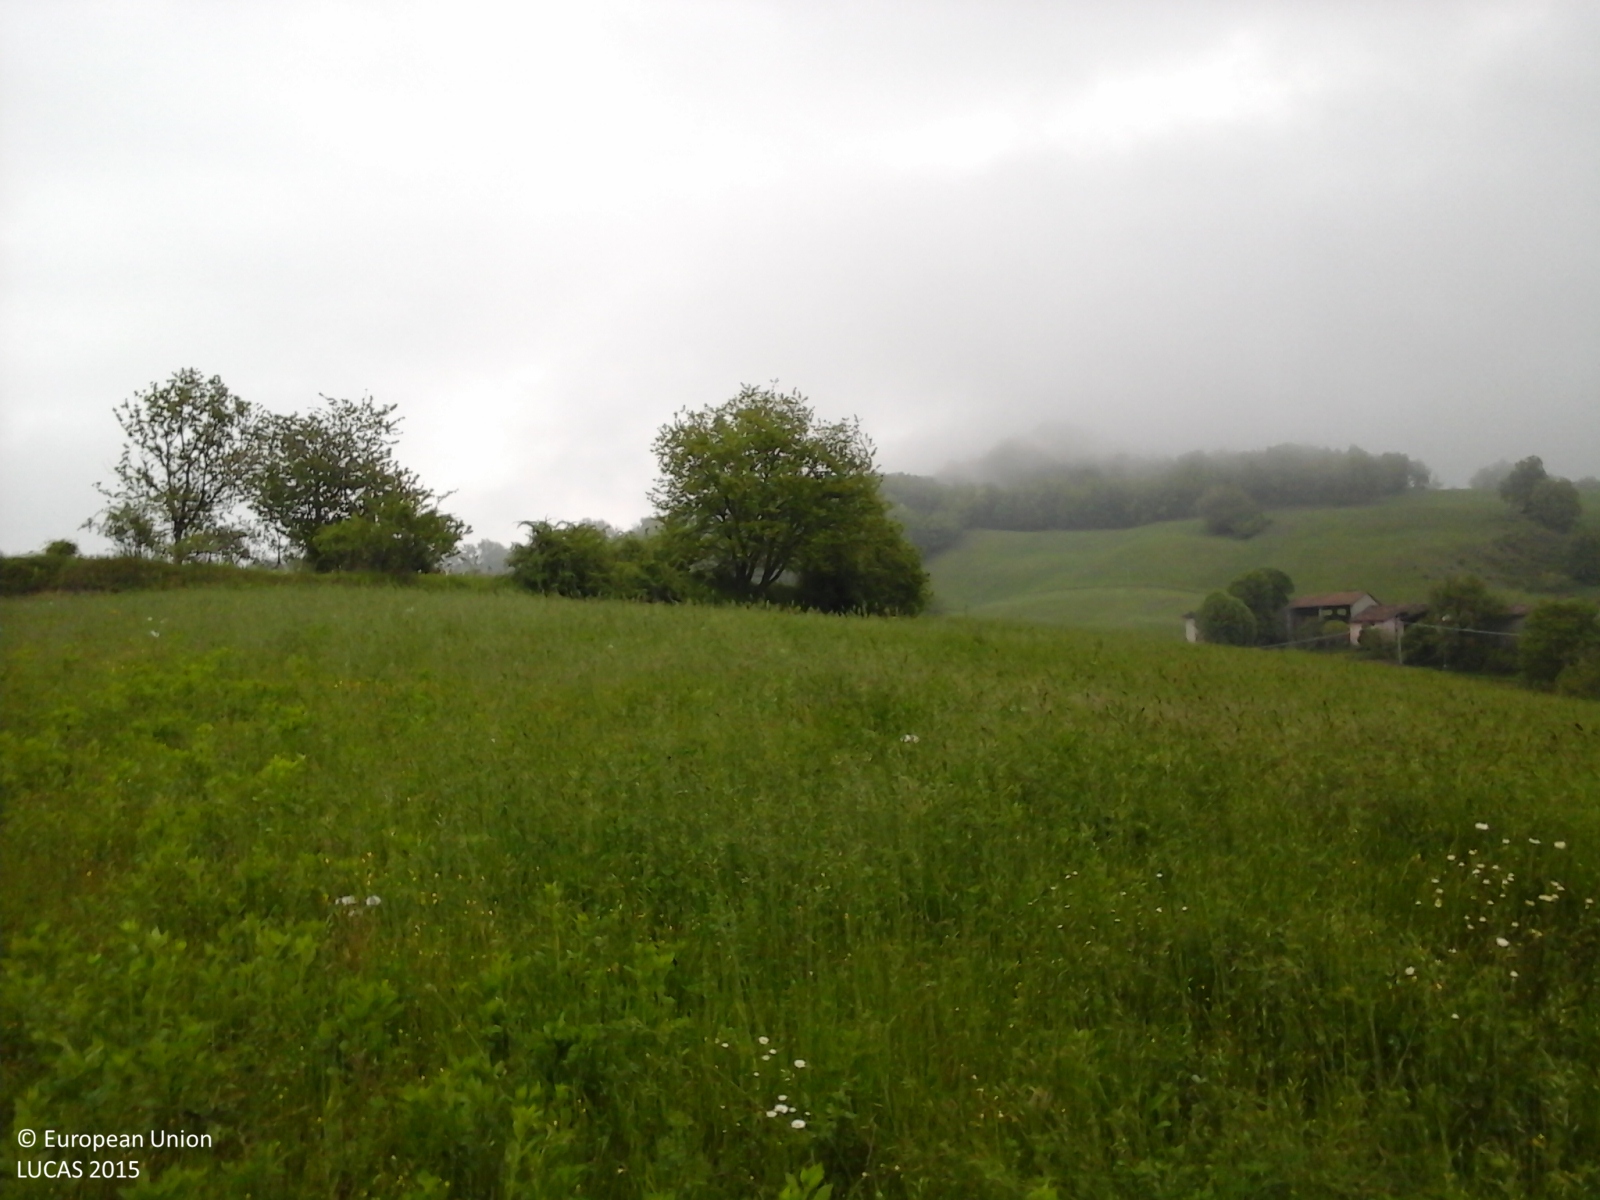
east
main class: Cropland
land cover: Other leguminous and mixtures for fodder
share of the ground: > 75 %
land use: Agriculture (excluding fallow land and kitchen gardens)
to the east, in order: Other leguminous and mixtures for fodder; Managed hedges; Grassland with sparse tree/shrub cover; Grassland without tree/shrub cover; Ditches and canals; Common wheat
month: April
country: IT
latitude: 44.8897
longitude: 9.3808
